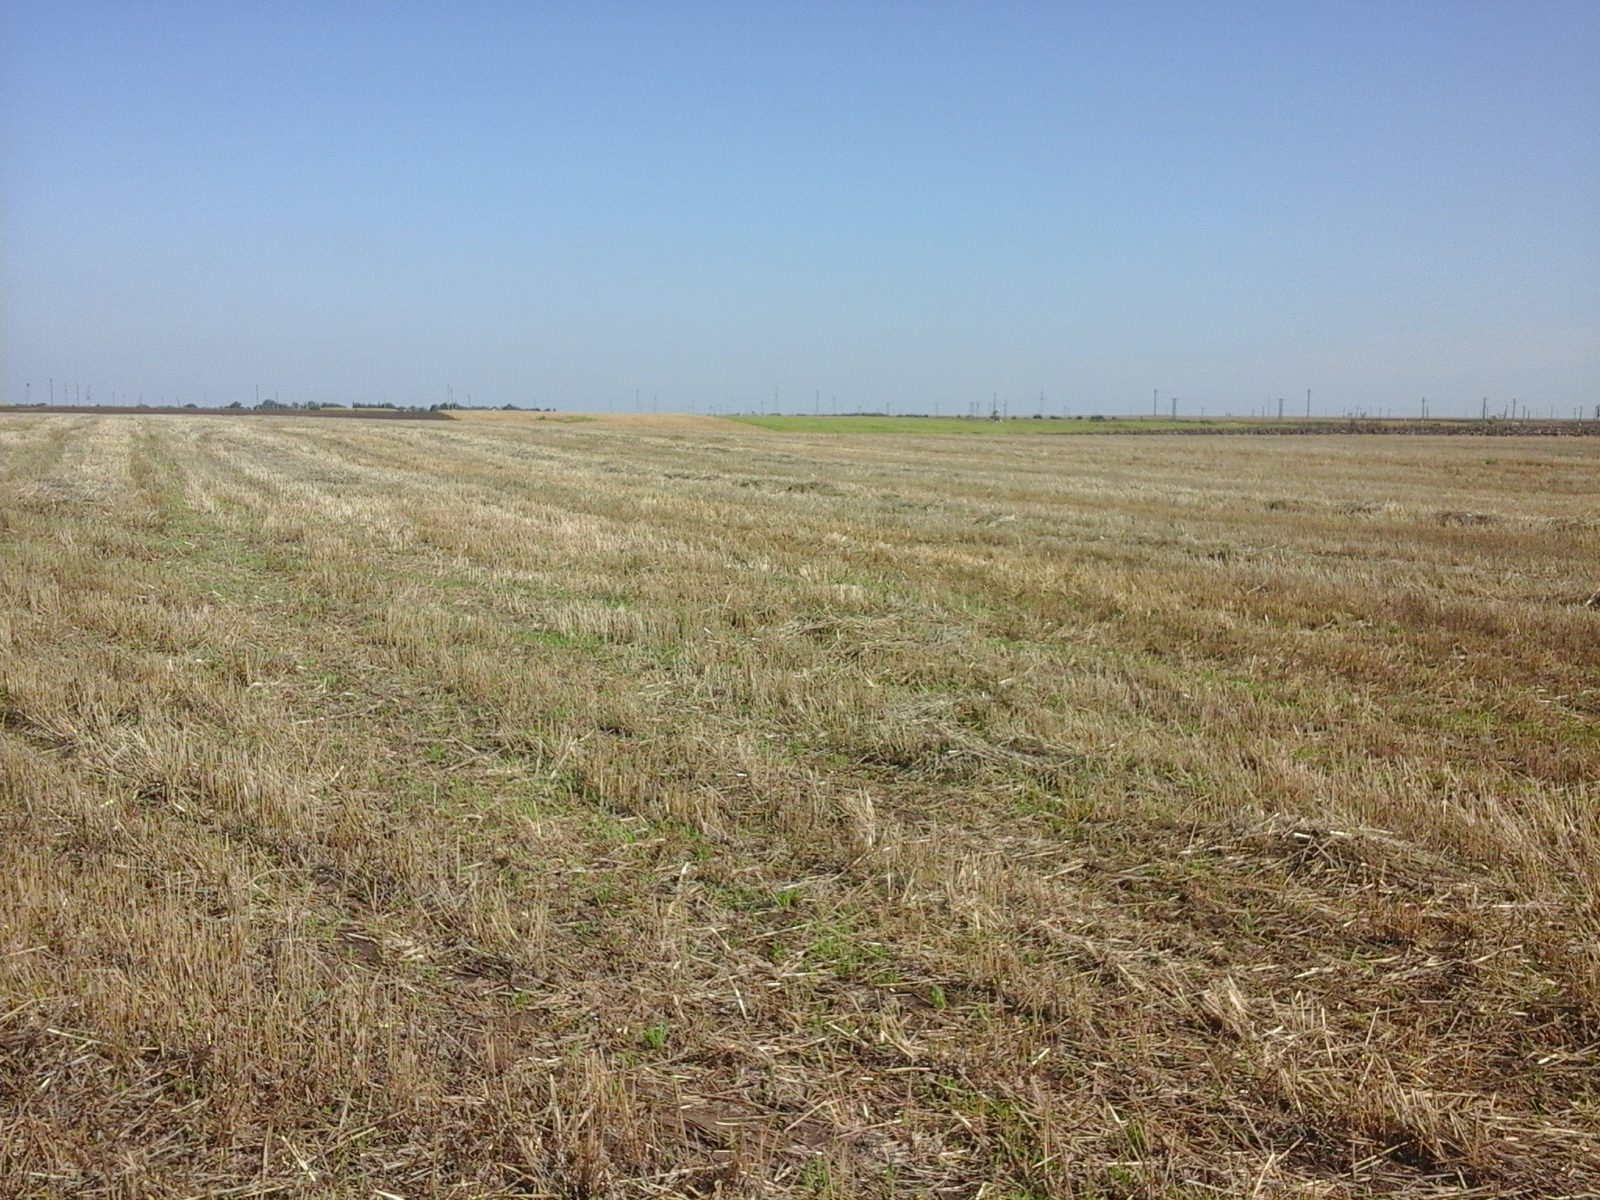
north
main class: Cropland
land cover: Common wheat
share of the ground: 25 - 50 %
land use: Agriculture (excluding fallow land and kitchen gardens)
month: August
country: RO
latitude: 45.9218
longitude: 21.0541
